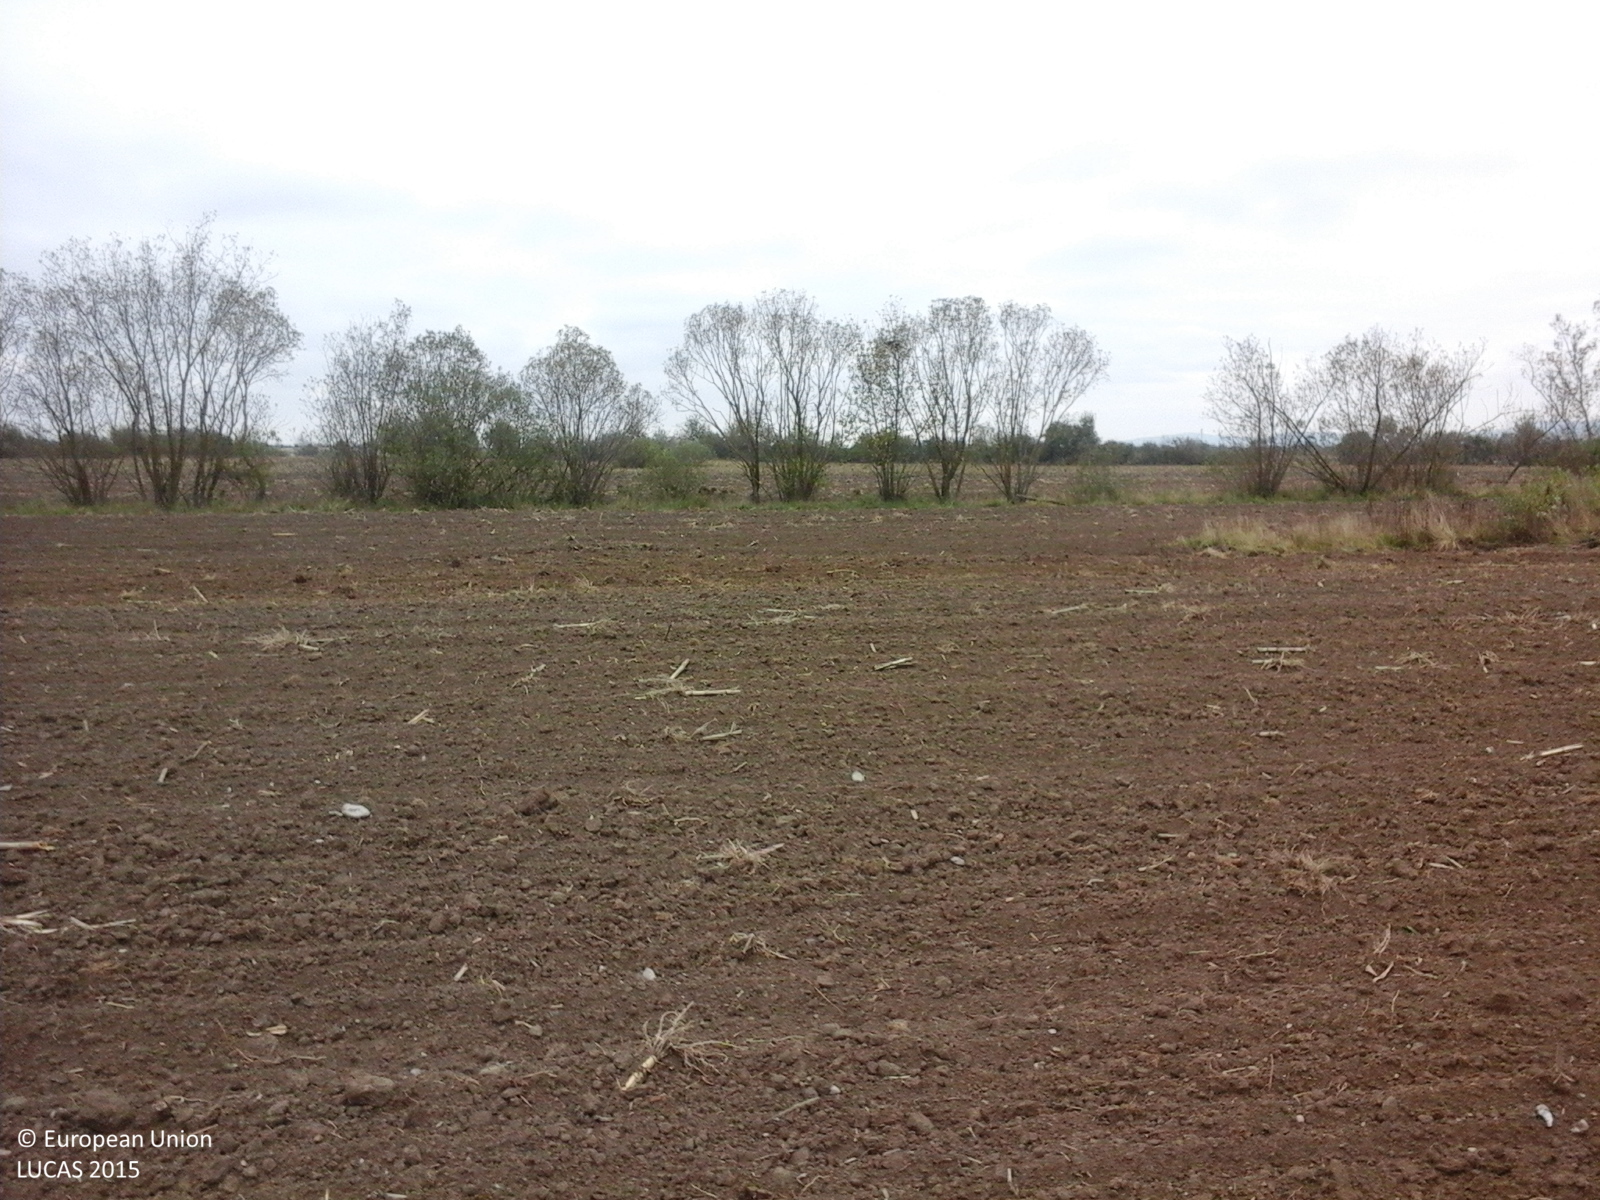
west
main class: Cropland
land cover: Maize
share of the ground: < 10 %
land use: Agriculture (excluding fallow land and kitchen gardens)
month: October
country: RO
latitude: 45.7913
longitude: 24.9228
